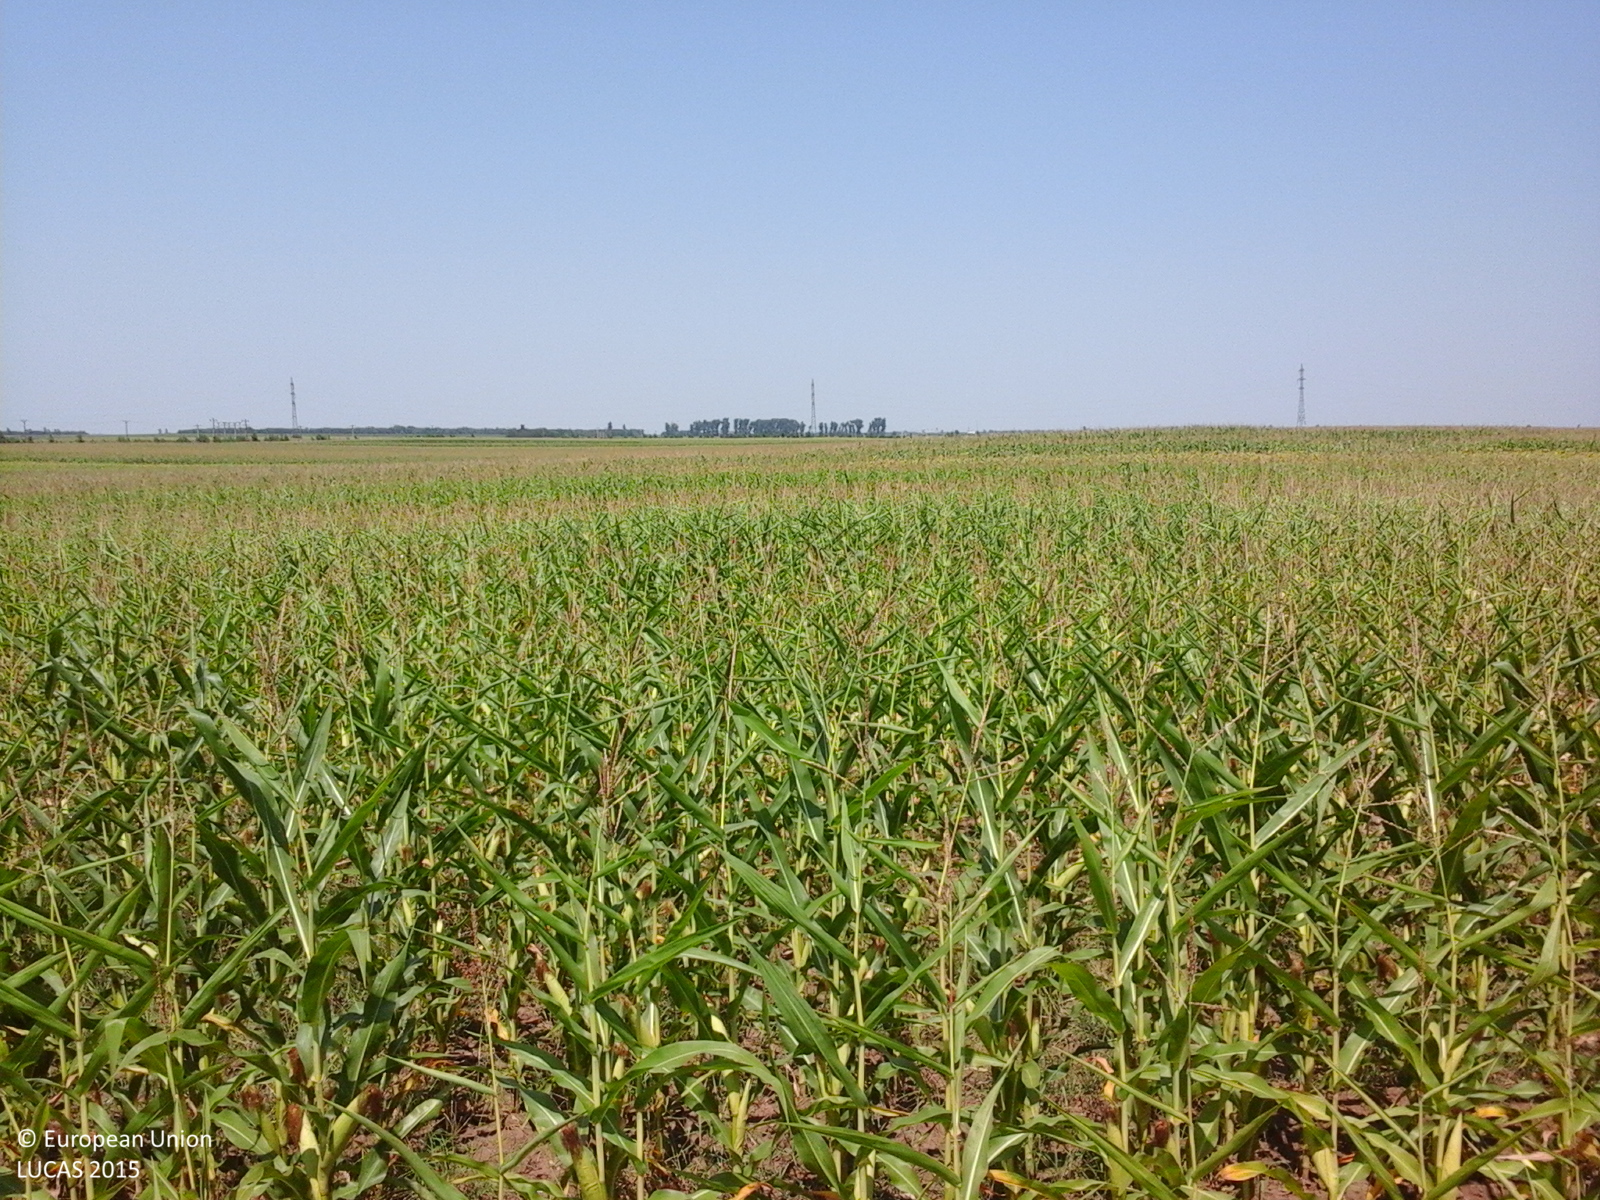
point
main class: Cropland
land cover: Maize
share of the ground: > 75 %
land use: Agriculture (excluding fallow land and kitchen gardens)
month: July
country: RO
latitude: 44.9003
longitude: 27.3533
